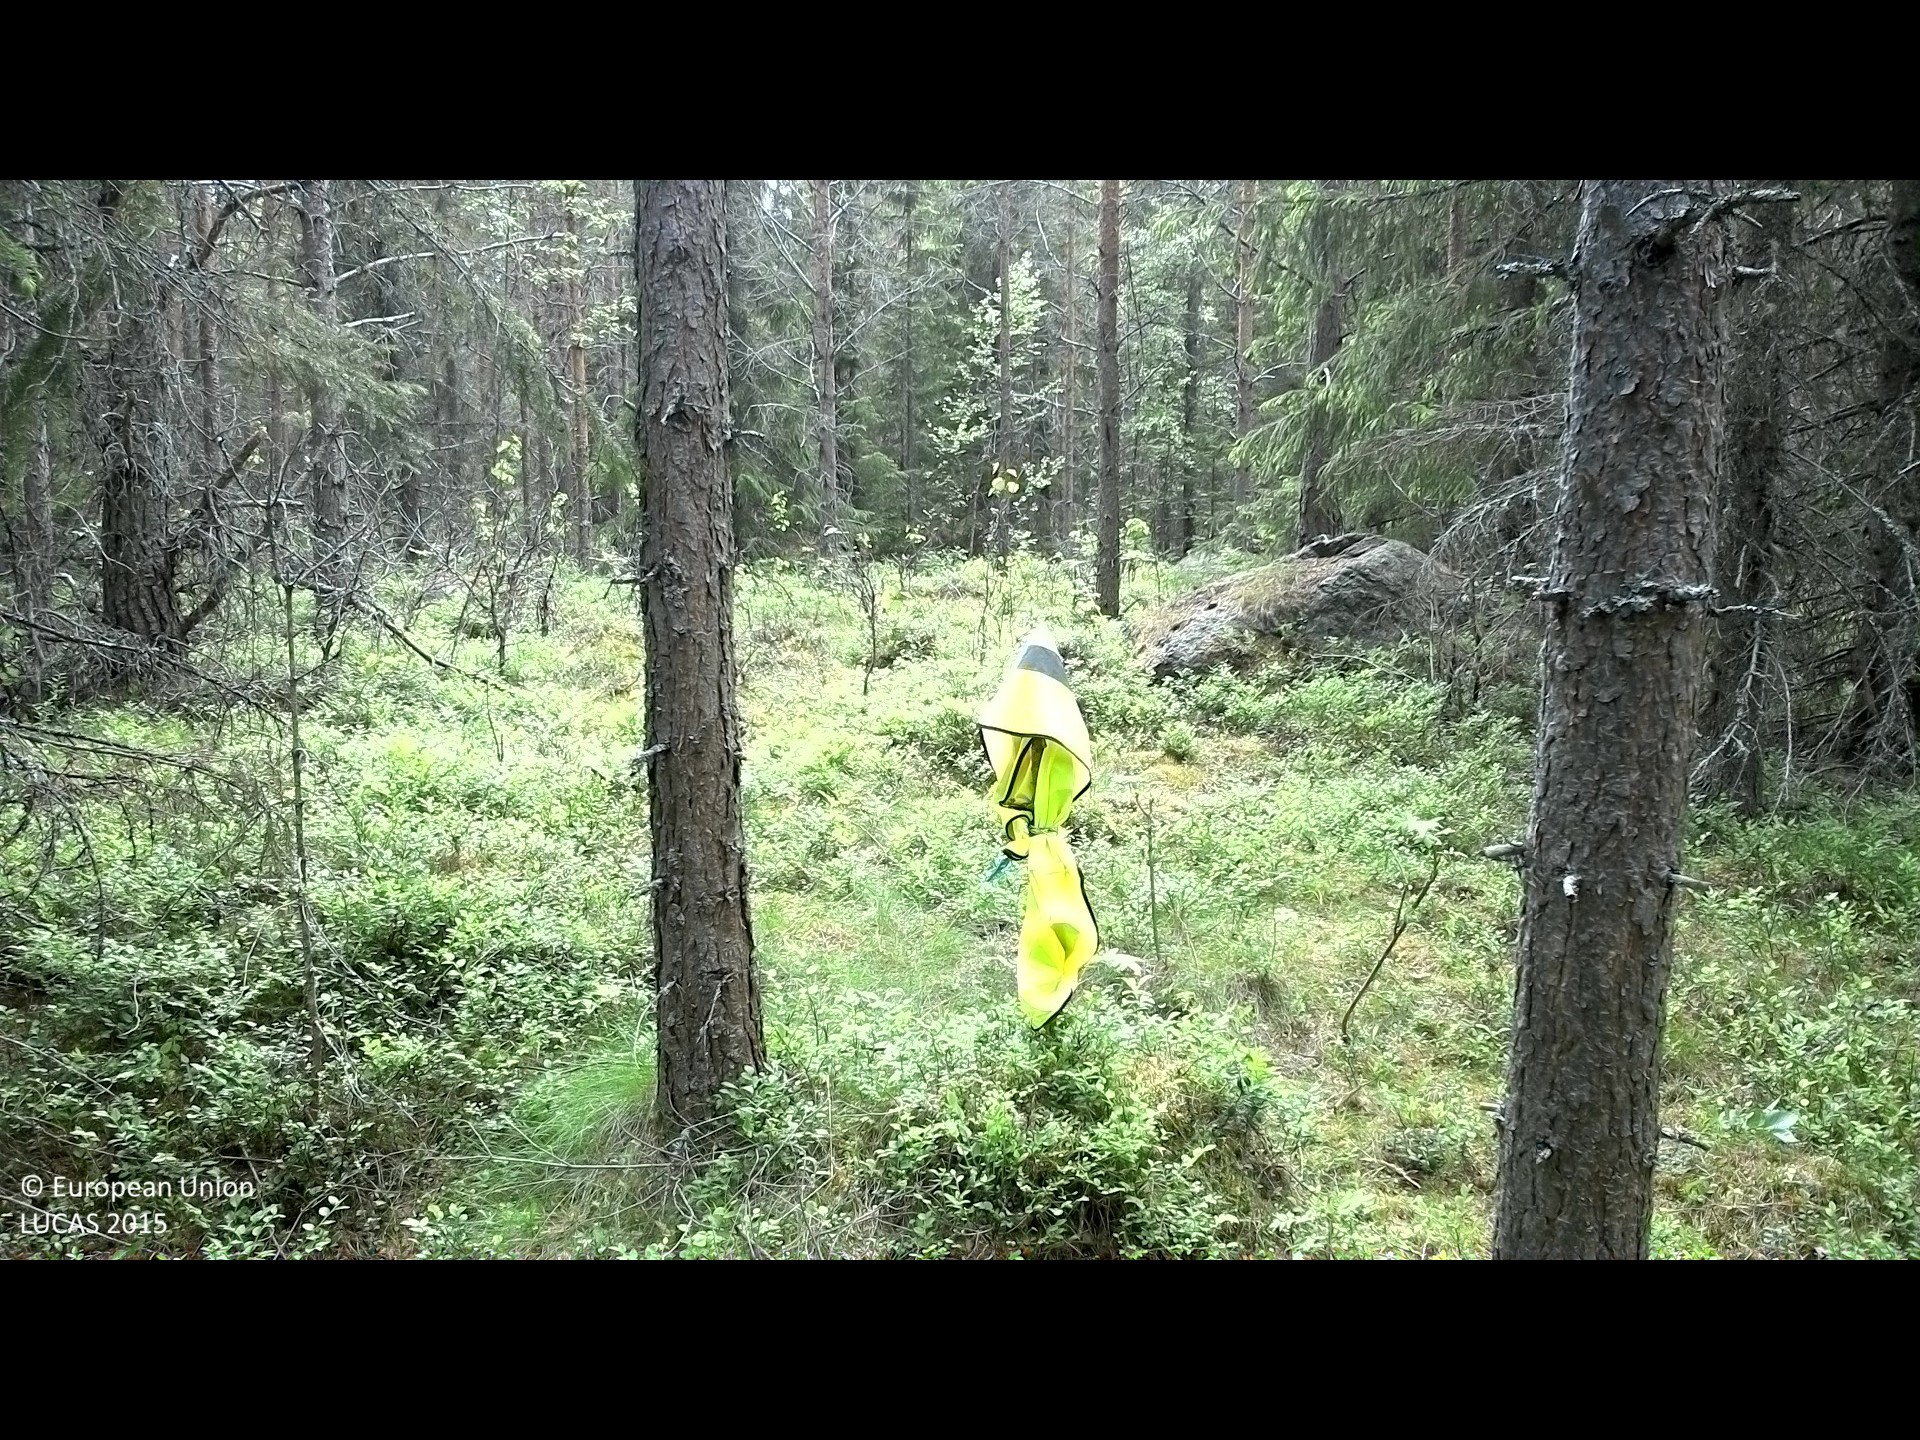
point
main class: Woodland
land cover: Spruce dominated coniferous woodland
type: boreal forest
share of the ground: 25 - 50 %
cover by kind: shrubs 45 %, coniferous forest trees 40 %, lichens and mosses 10 %, broadleaved forest trees 5 %
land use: Forestry
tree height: > 5 m
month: June
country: SE
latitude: 62.1204
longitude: 17.4392
